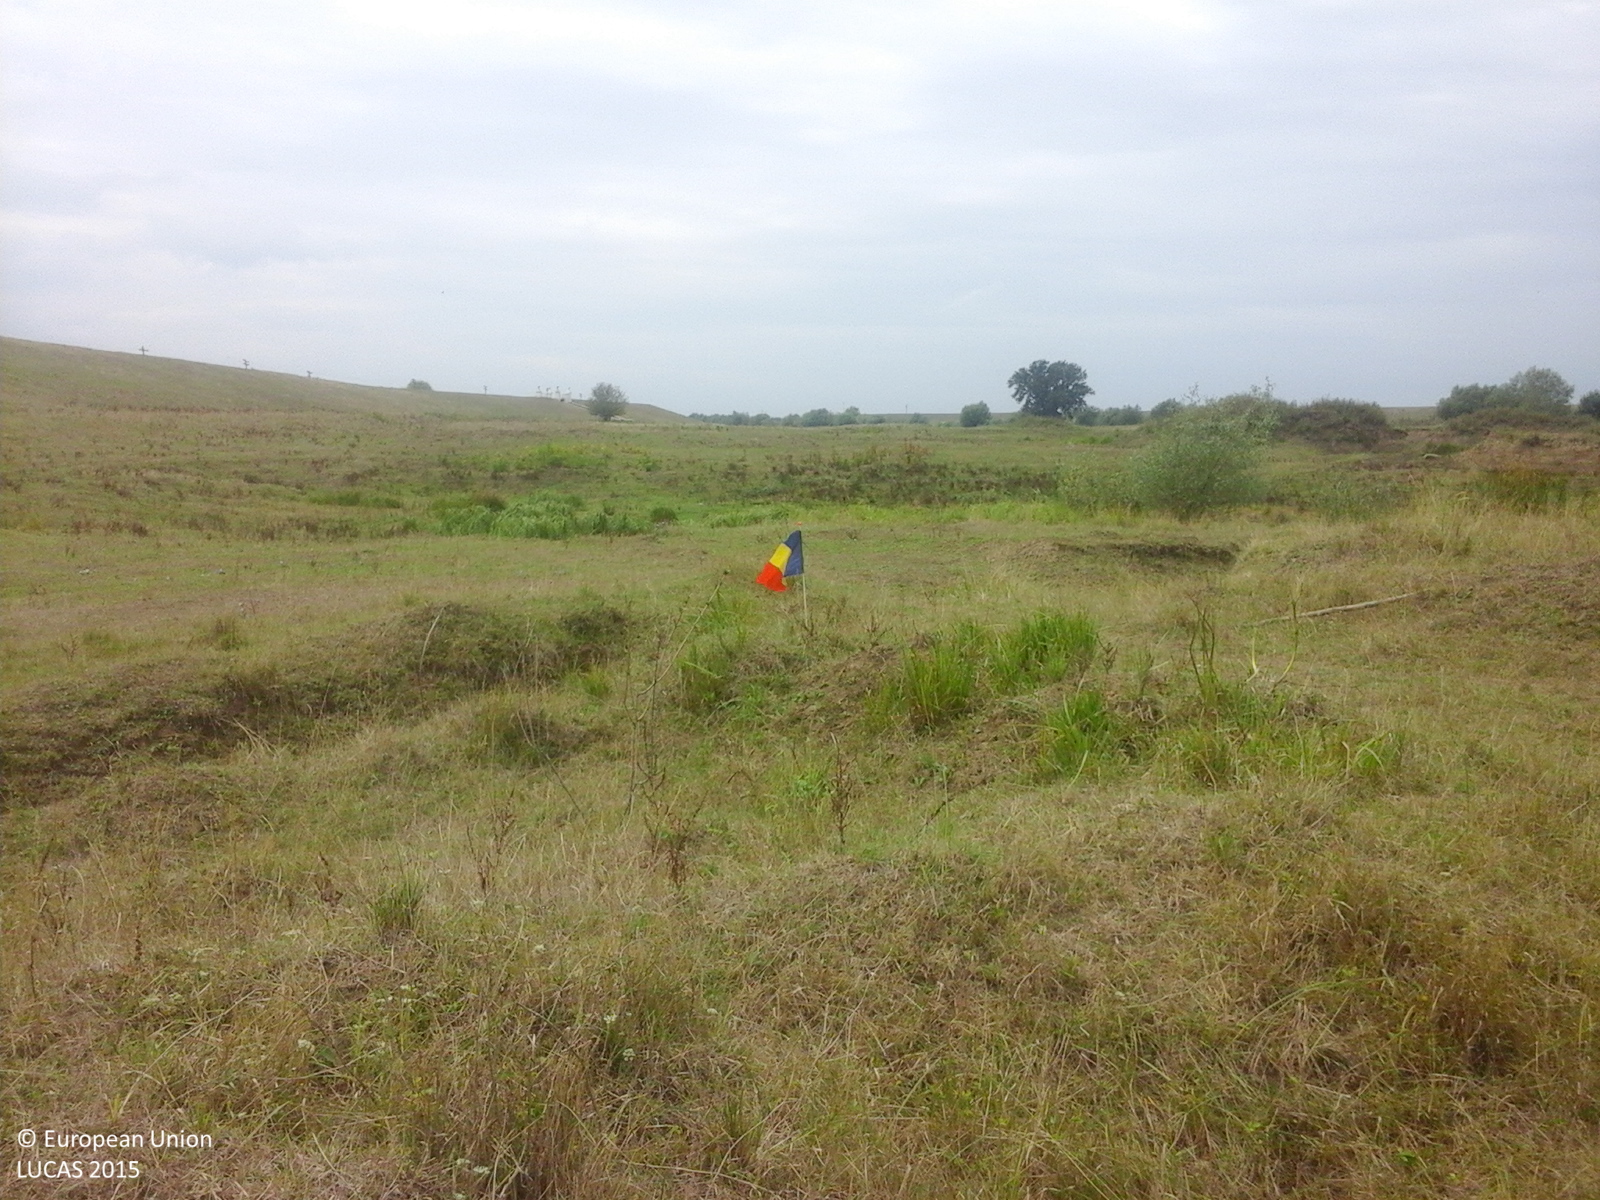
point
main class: Grassland
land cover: Grassland without tree/shrub cover
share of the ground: > 75 %
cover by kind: herbaceous plants 100 %
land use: Agriculture (excluding fallow land and kitchen gardens)
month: August
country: RO
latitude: 45.4743
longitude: 20.9889
